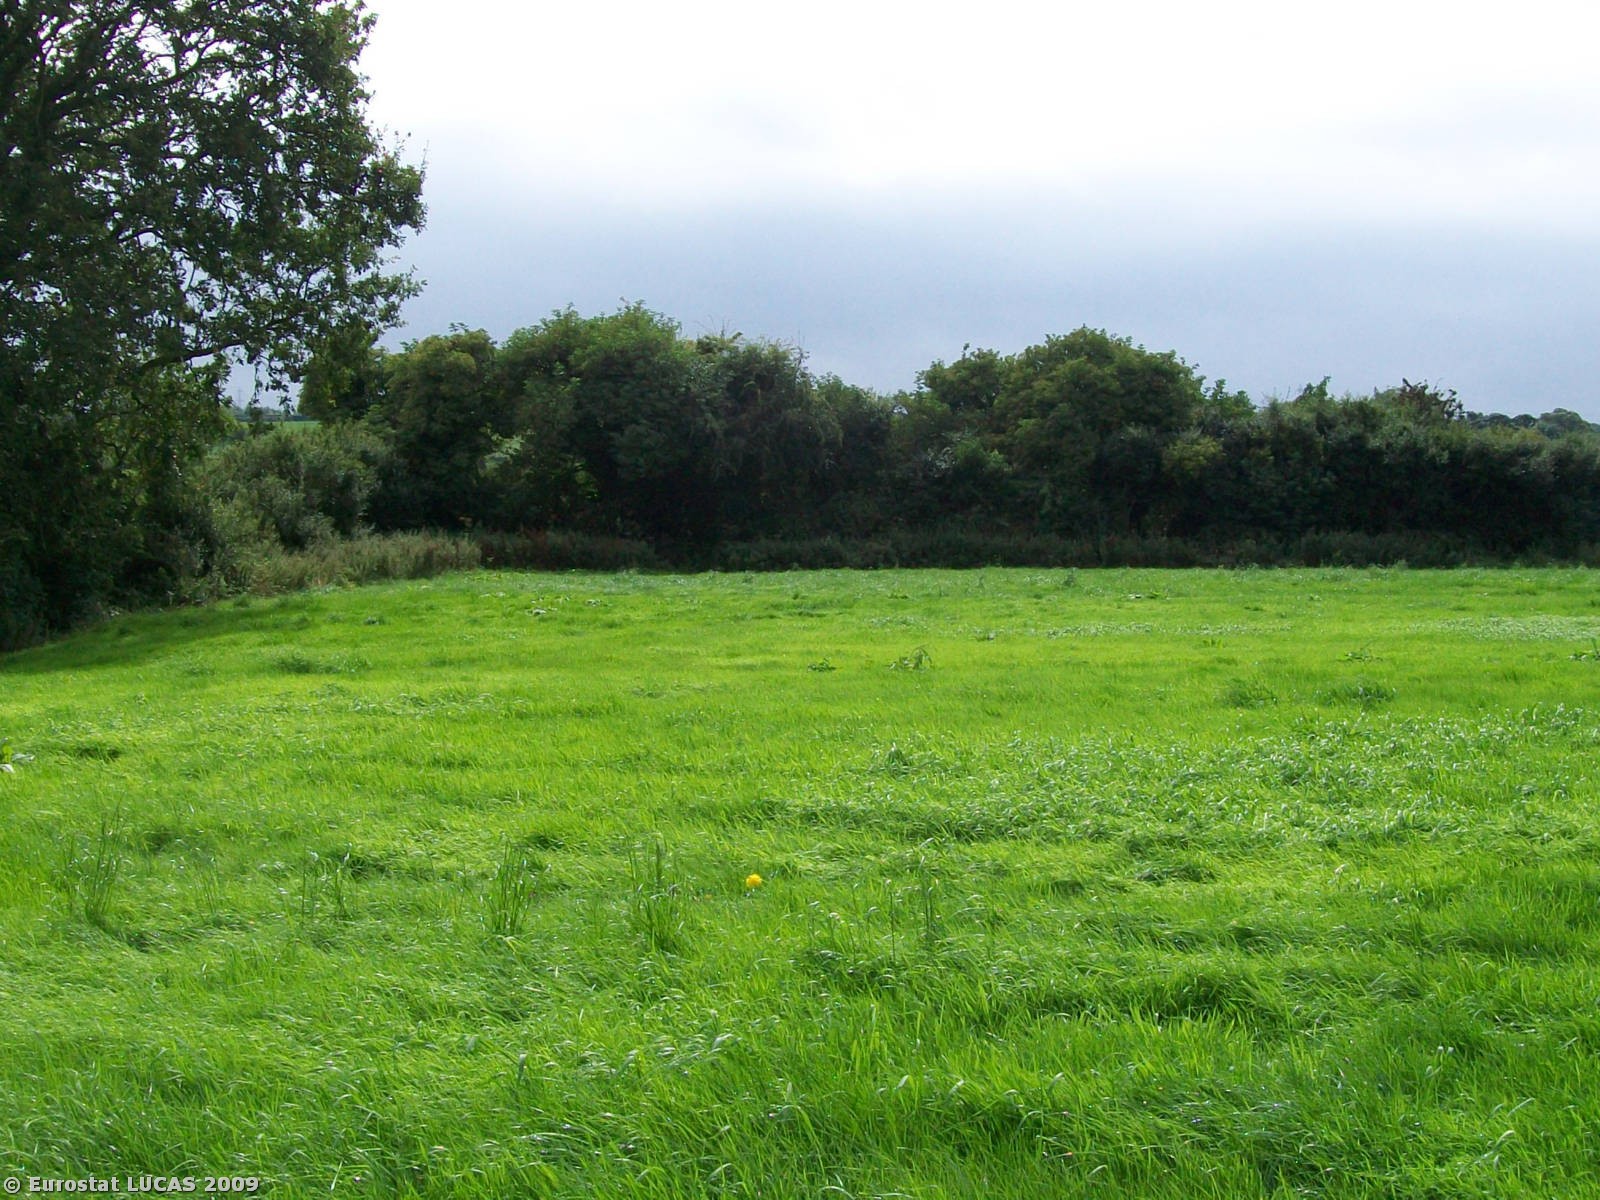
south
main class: Grassland
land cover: Grassland without tree/shrub cover
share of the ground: > 75 %
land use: Agriculture (excluding fallow land and kitchen gardens)
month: August
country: GB
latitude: 54.4867
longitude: -6.0574
